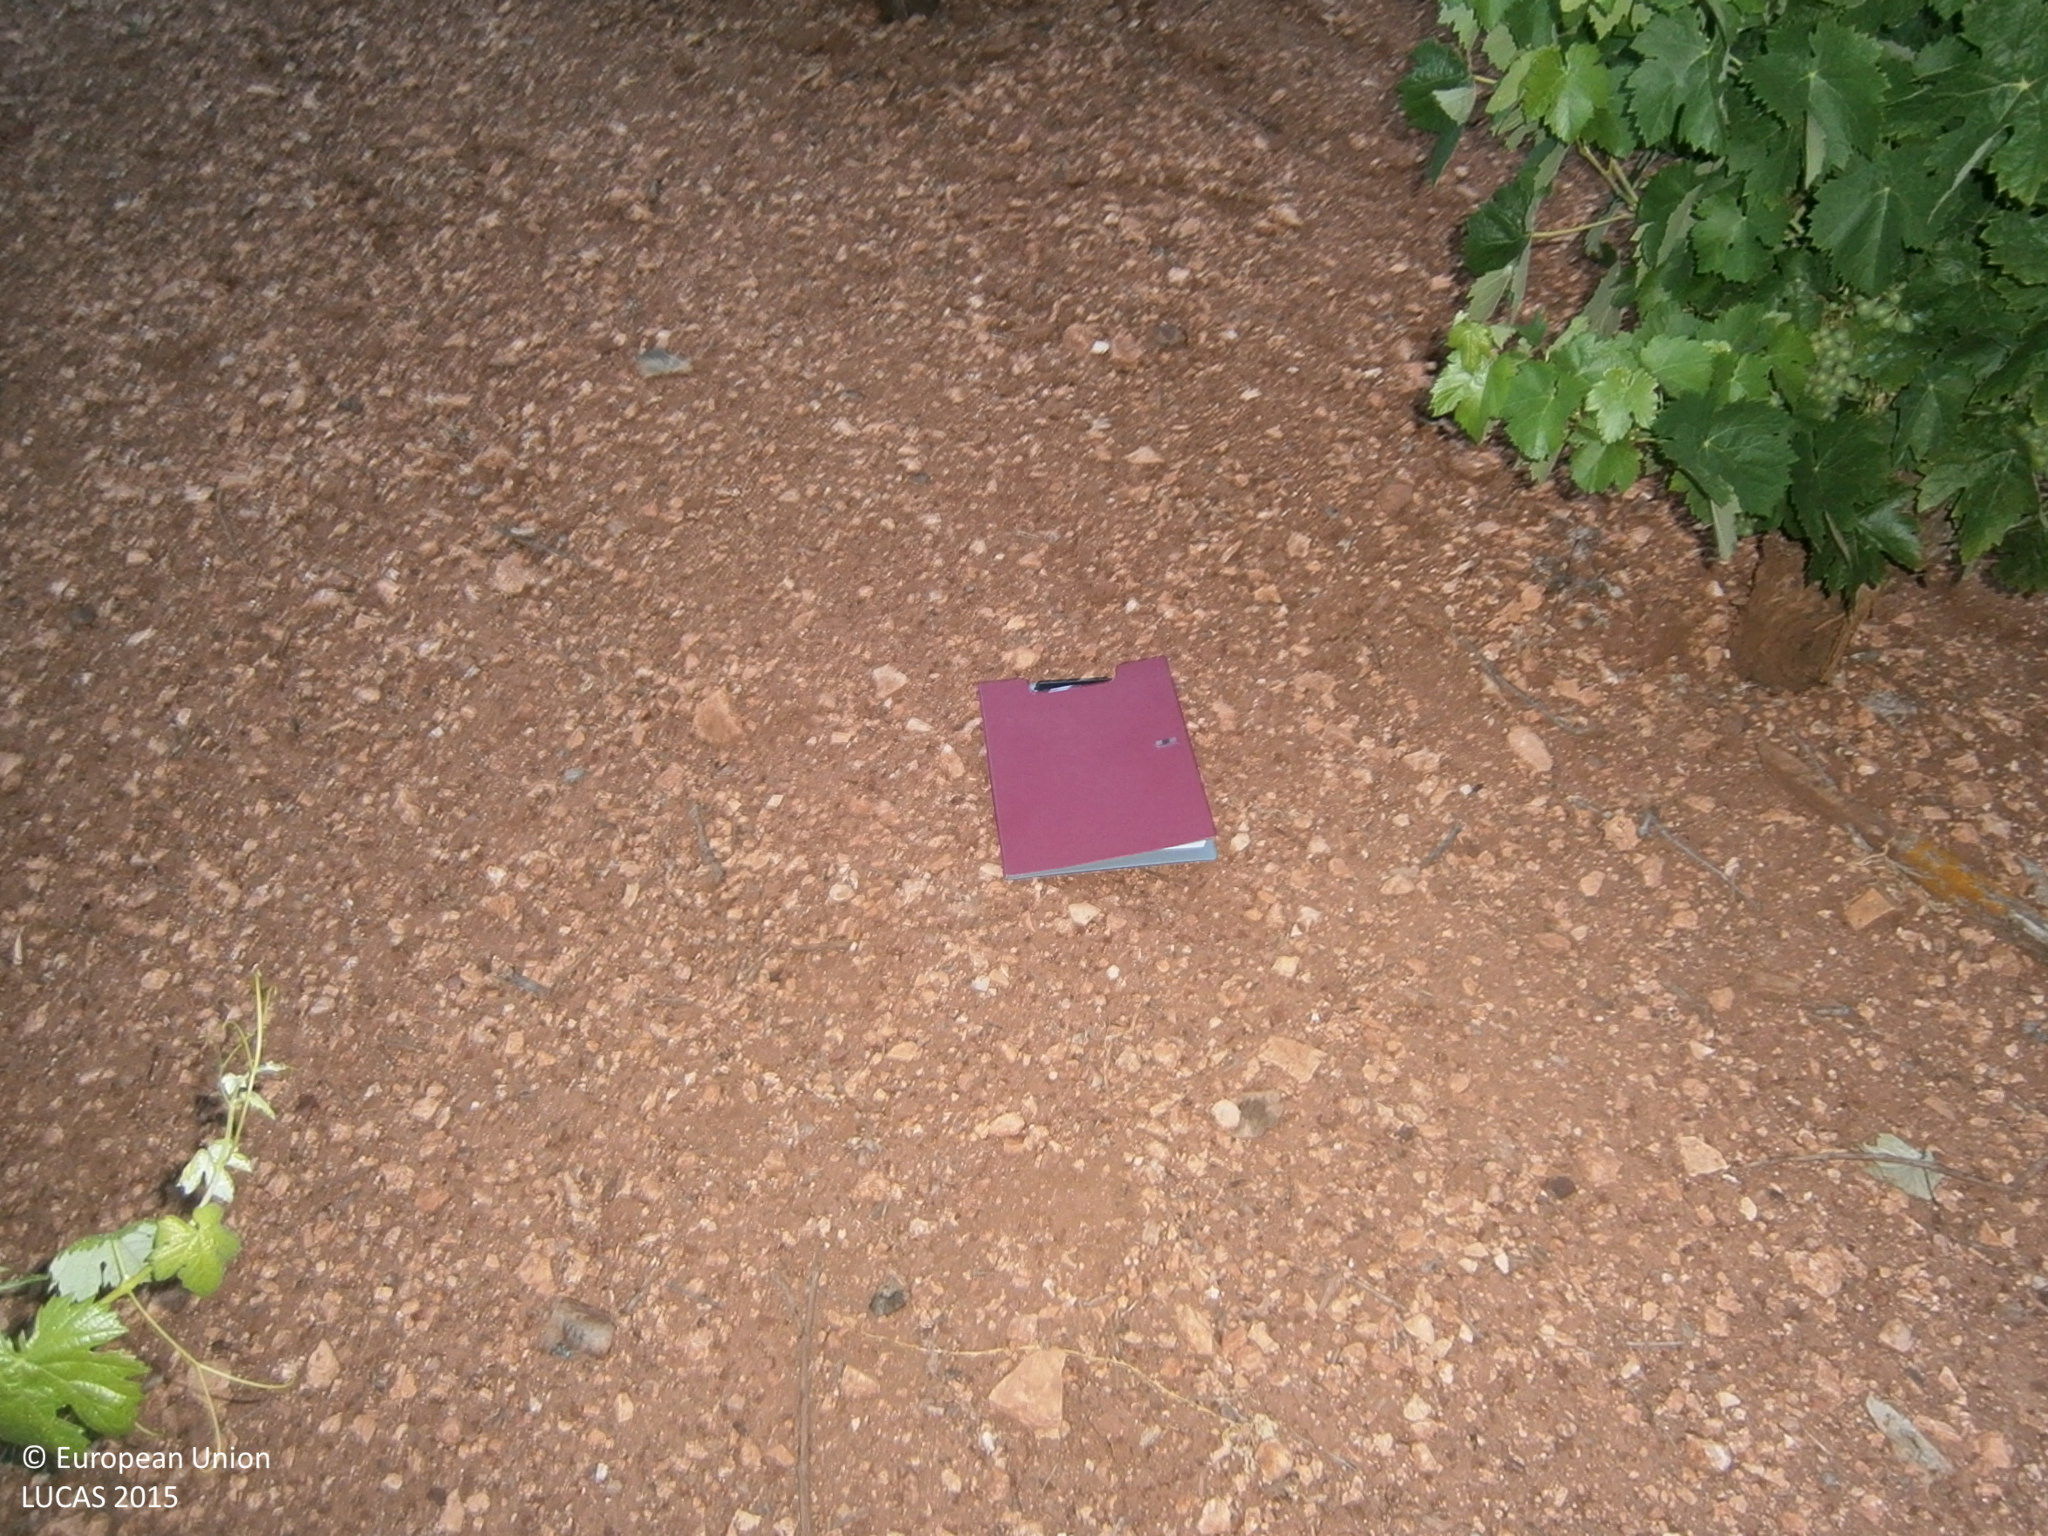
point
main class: Cropland
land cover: Vineyards
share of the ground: 25 - 50 %
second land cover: Other bare soil
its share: > 75 %
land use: Agriculture (excluding fallow land and kitchen gardens)
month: June
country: ES
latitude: 38.5623
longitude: -6.4063
